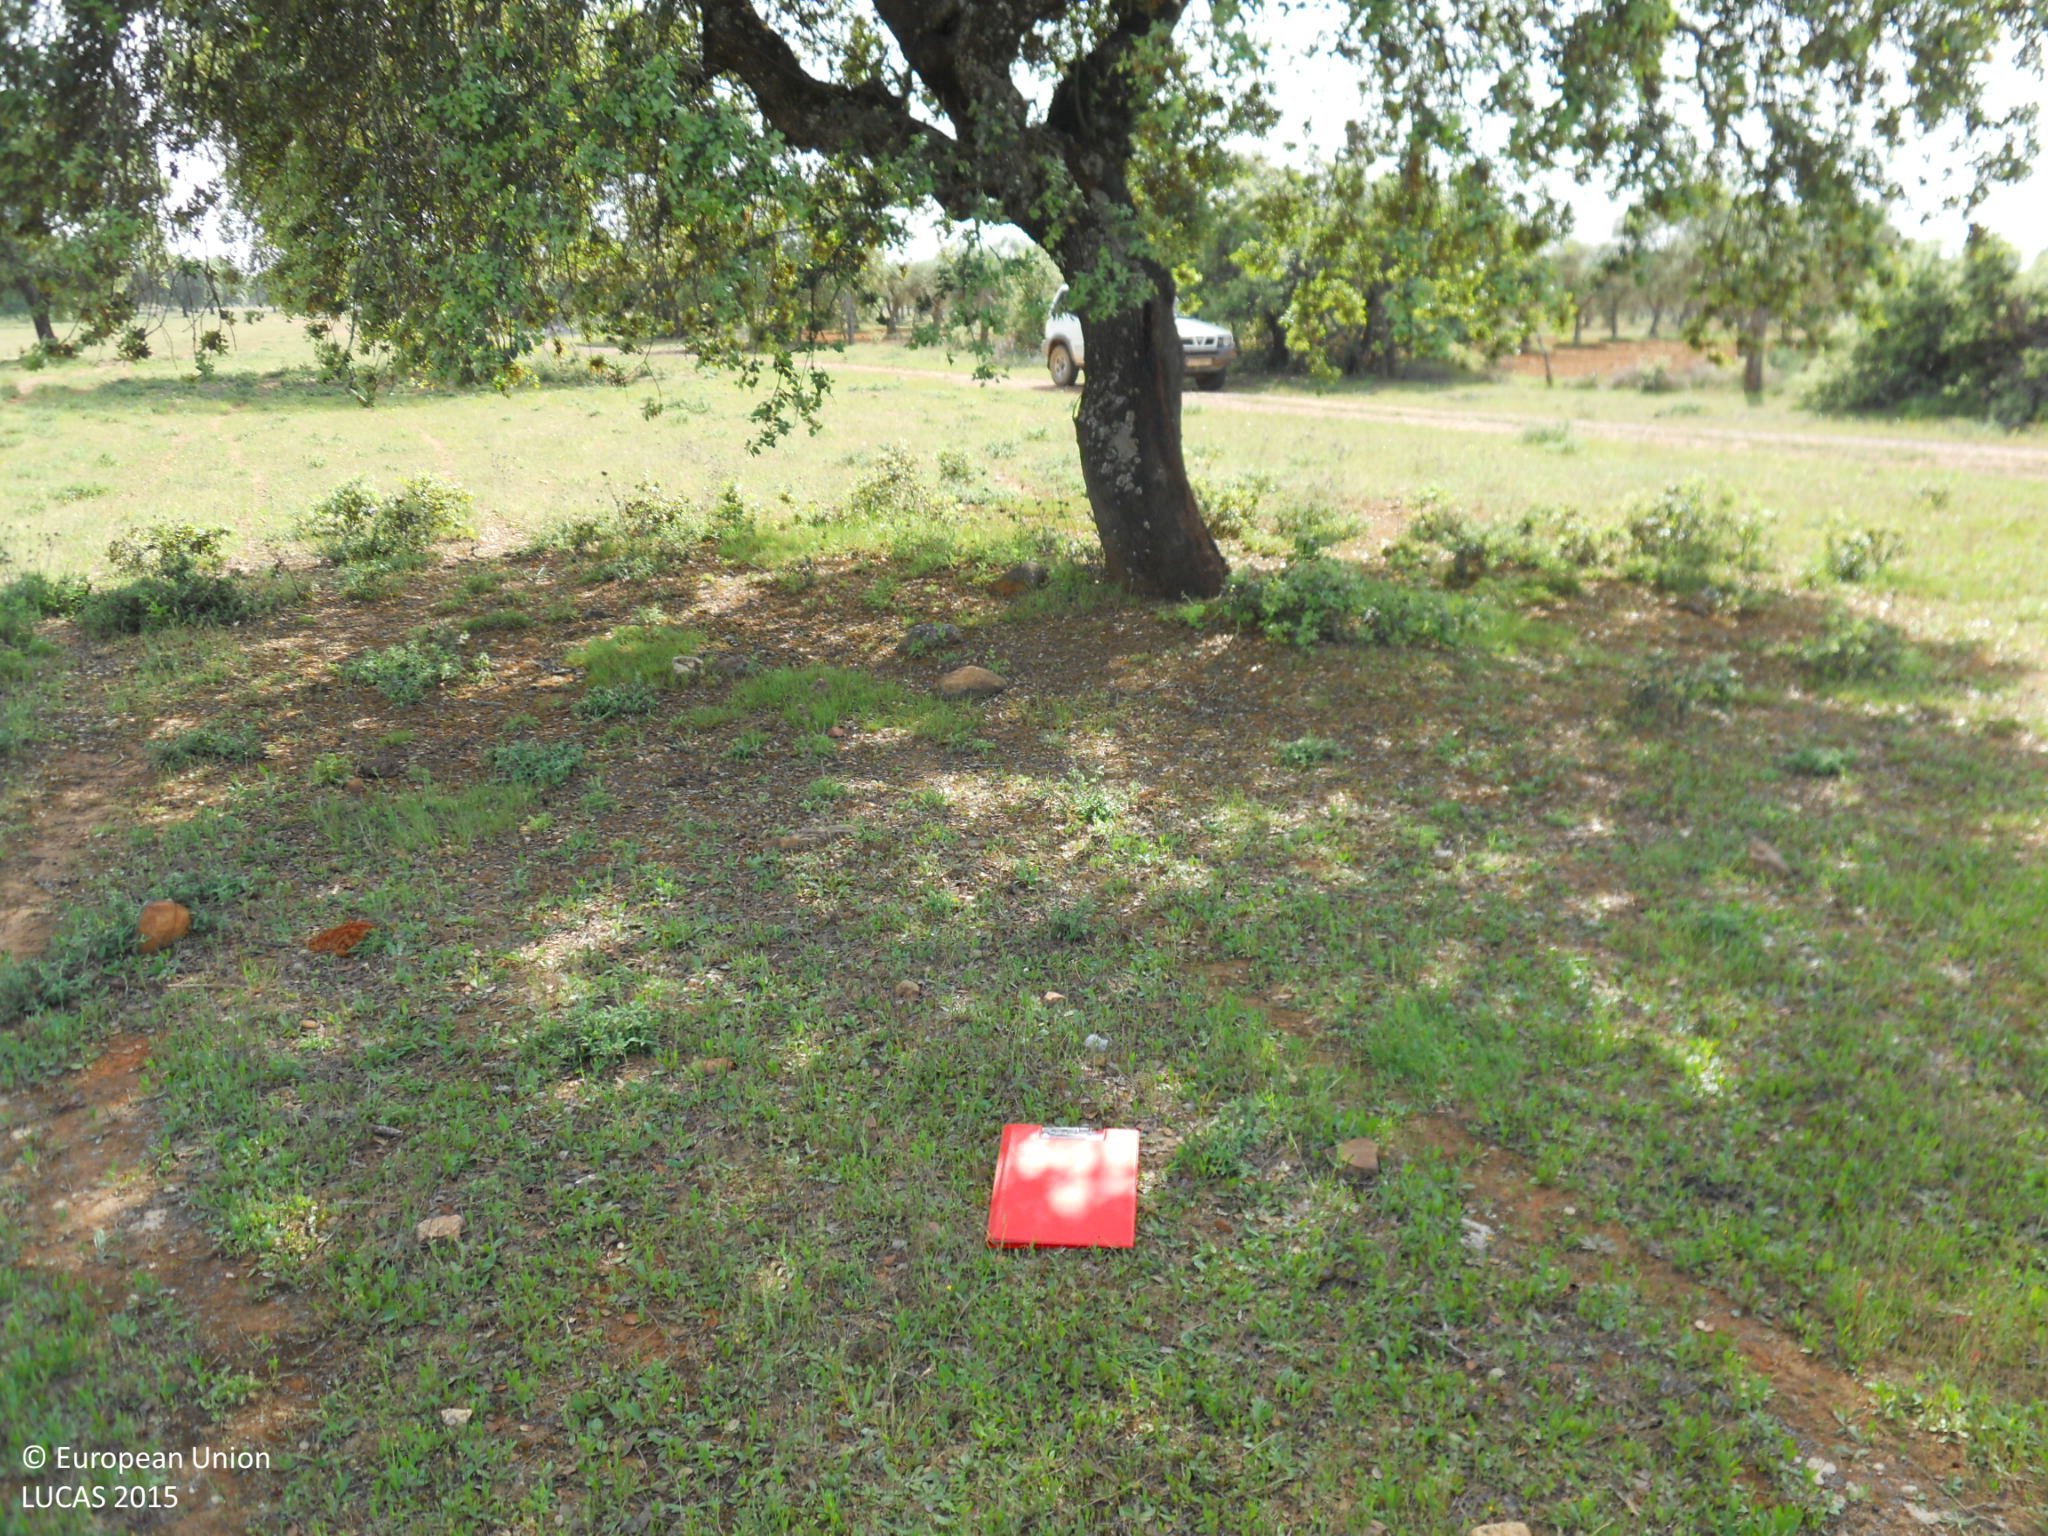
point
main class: Woodland
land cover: Broadleaved woodland
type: broadleaved evergreen forest
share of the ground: 25 - 50 %
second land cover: Grassland without tree/shrub cover
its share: > 75 %
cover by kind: herbaceous plants 75 %, broadleaved forest trees 25 %
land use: Forestry
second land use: Agriculture (excluding fallow land and kitchen gardens)
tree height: > 5 m
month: April
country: ES
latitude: 39.1408
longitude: -6.3636
